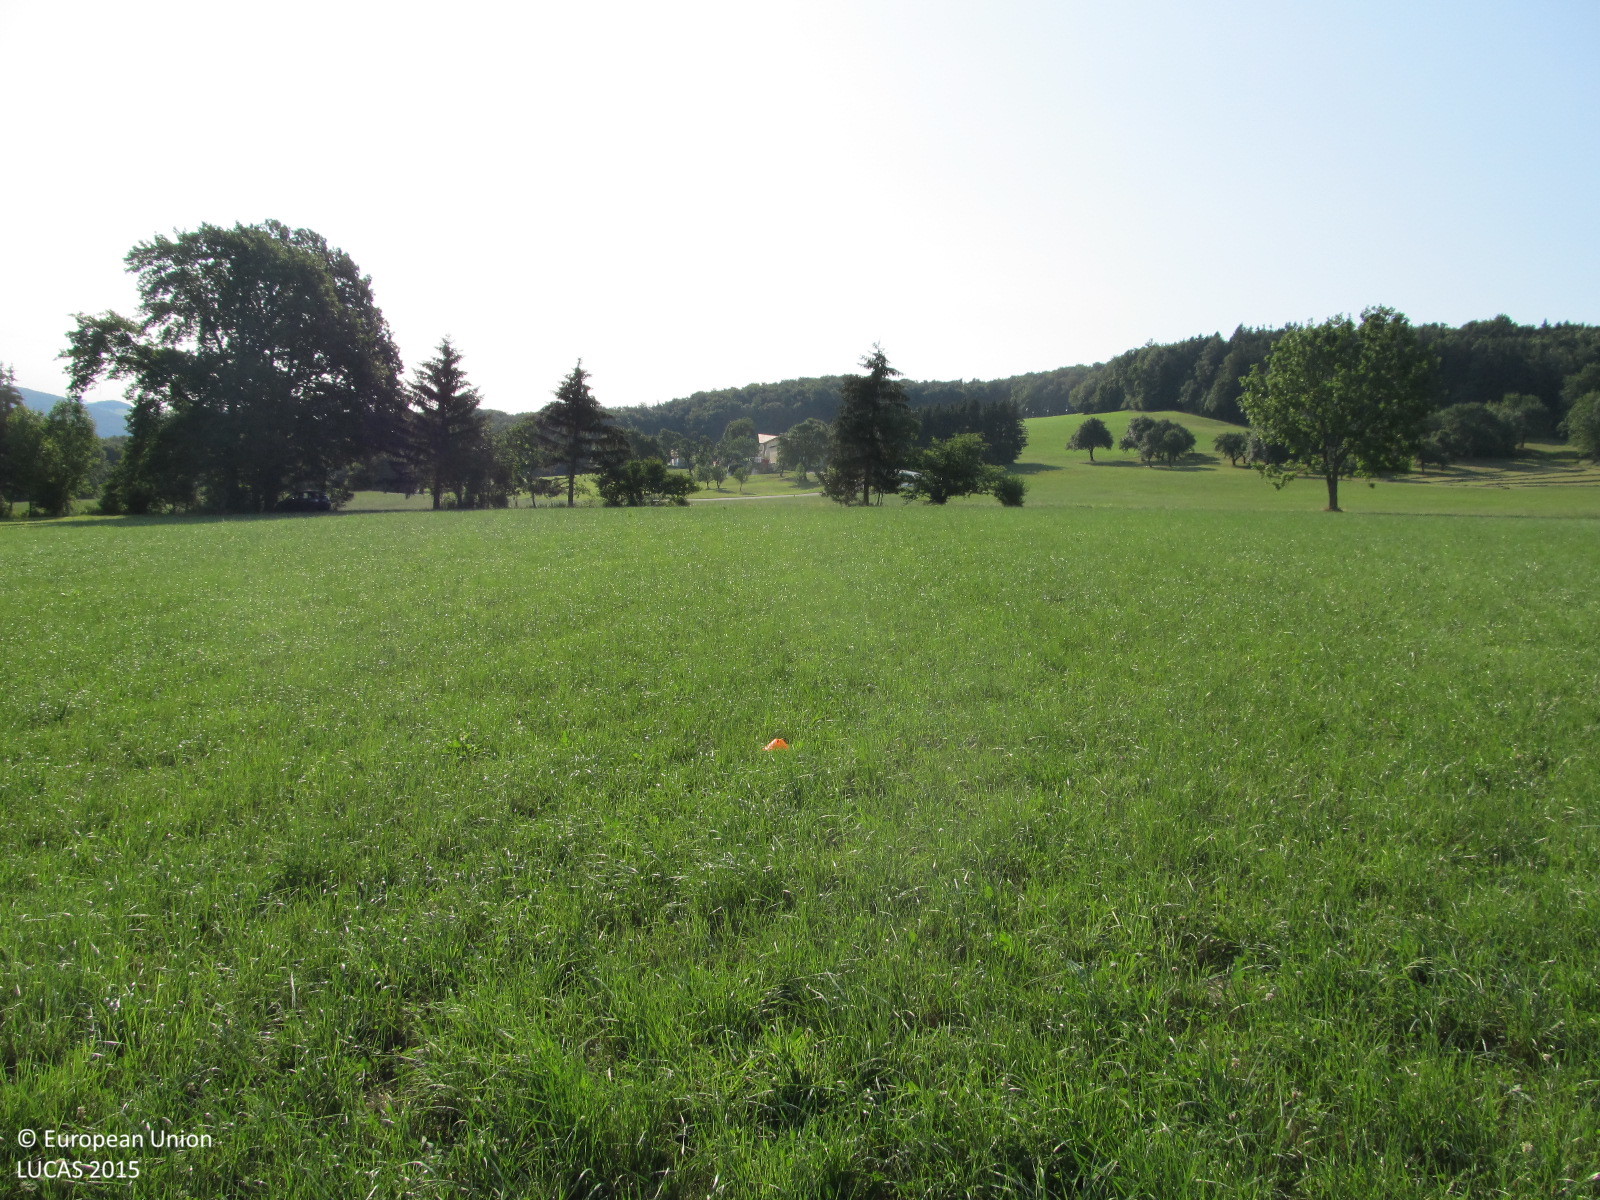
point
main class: Grassland
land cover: Grassland without tree/shrub cover
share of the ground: > 75 %
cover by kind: herbaceous plants 100 %
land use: Agriculture (excluding fallow land and kitchen gardens)
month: August
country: AT
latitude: 48.1447
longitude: 15.7687
